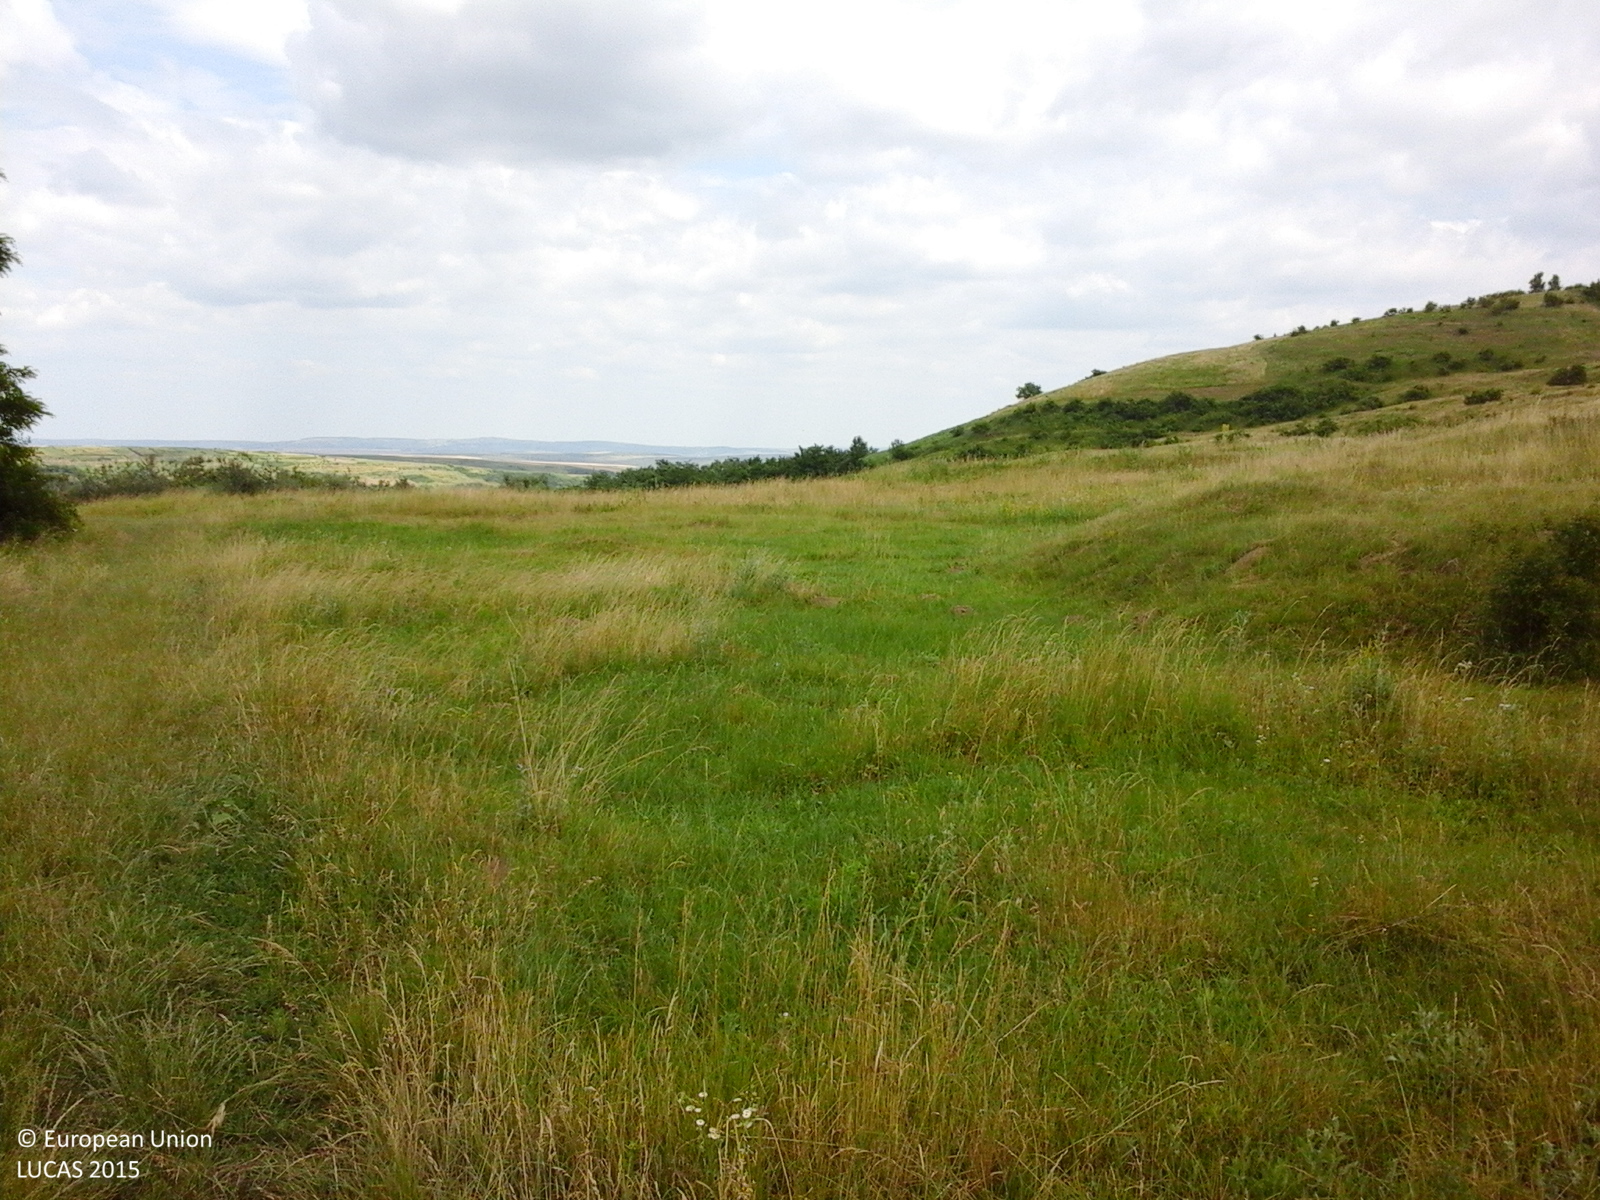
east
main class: Grassland
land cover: Grassland without tree/shrub cover
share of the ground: > 75 %
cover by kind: herbaceous plants 100 %
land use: Agriculture (excluding fallow land and kitchen gardens)
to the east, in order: Grassland without tree/shrub cover
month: June
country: RO
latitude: 46.7297
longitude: 27.4221
